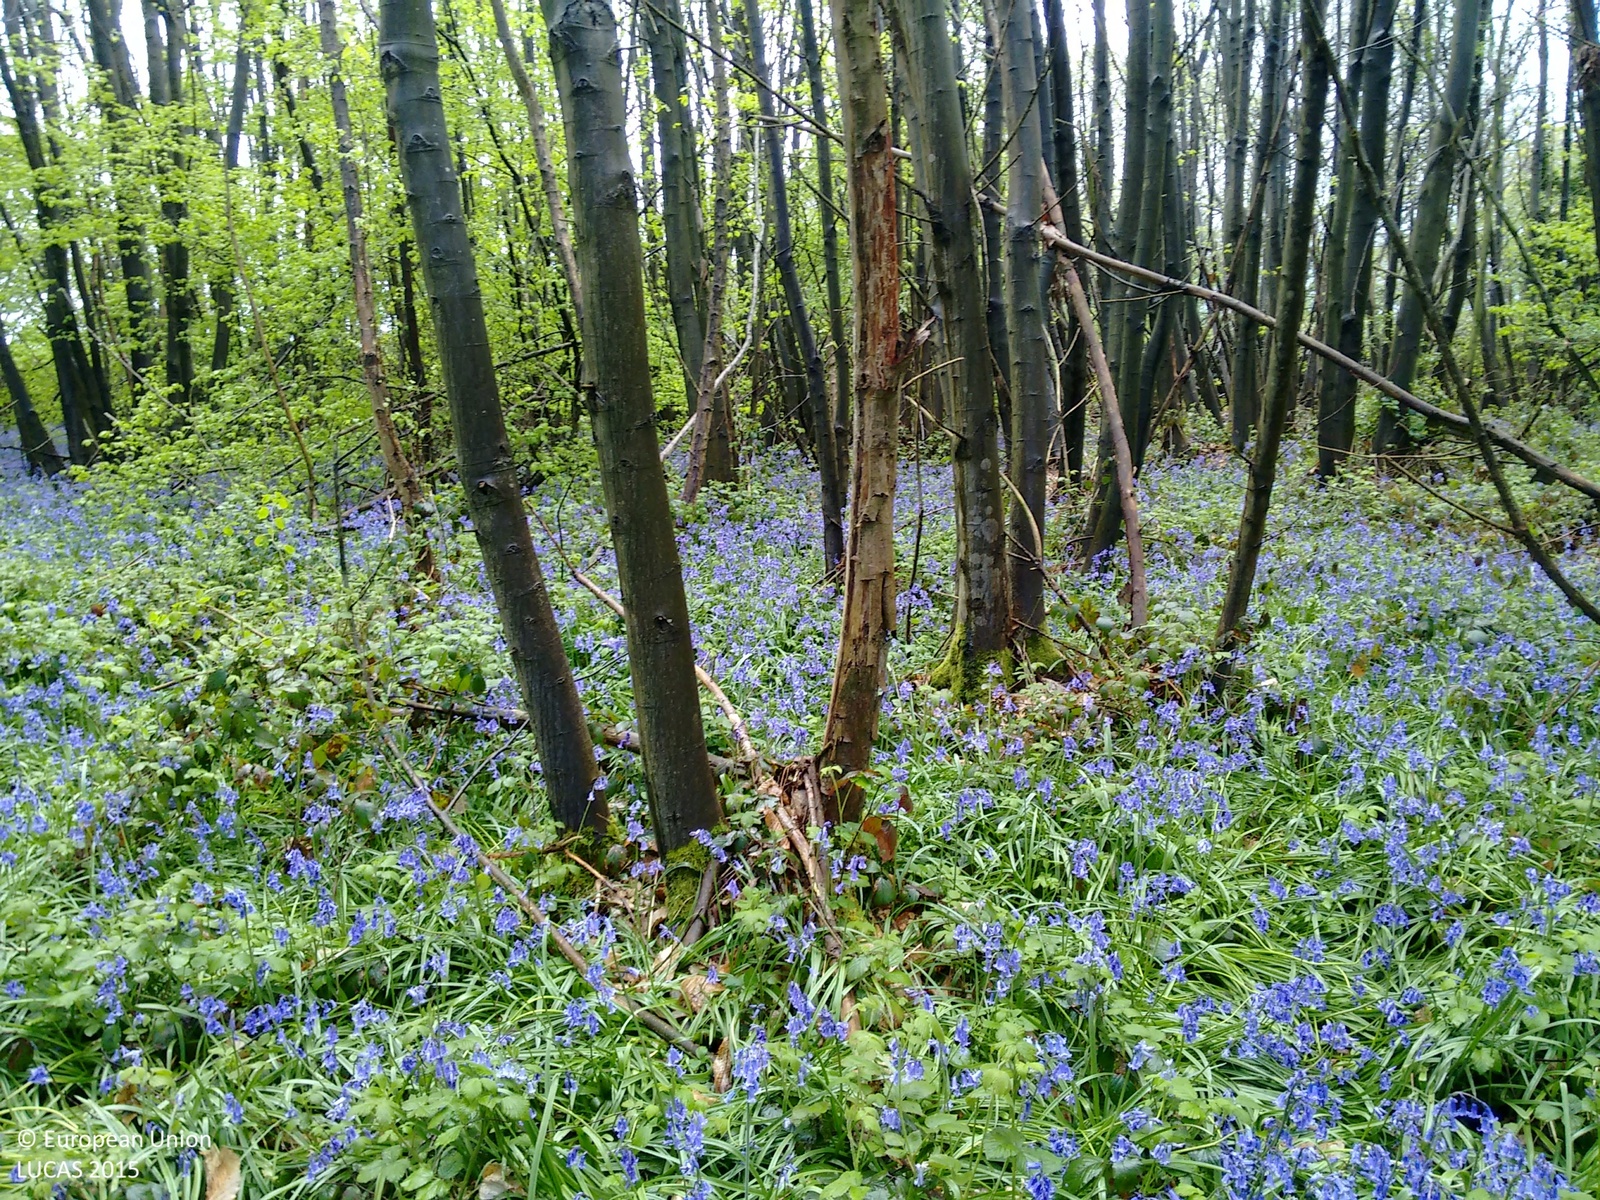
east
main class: Woodland
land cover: Broadleaved woodland
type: mesophytic deciduous forest
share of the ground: > 75 %
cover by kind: broadleaved forest trees 100 %
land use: Forestry
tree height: > 5 m
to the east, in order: Broadleaved woodland; Paved roads, cycling and walking lanes; Managed hedges; Grassland without tree/shrub cover; Broadleaved woodland; Fences; Paved roads, cycling and walking lanes; Managed hedges; Fences; Grassland without tree/shrub cover; Fences; Grassland without tree/shrub cover; Fences; Grassland without tree/shrub cover; Fences; Grassland without tree/shrub cover; Artificial constructions in urban areas
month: May
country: GB
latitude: 51.3212
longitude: 0.2263
